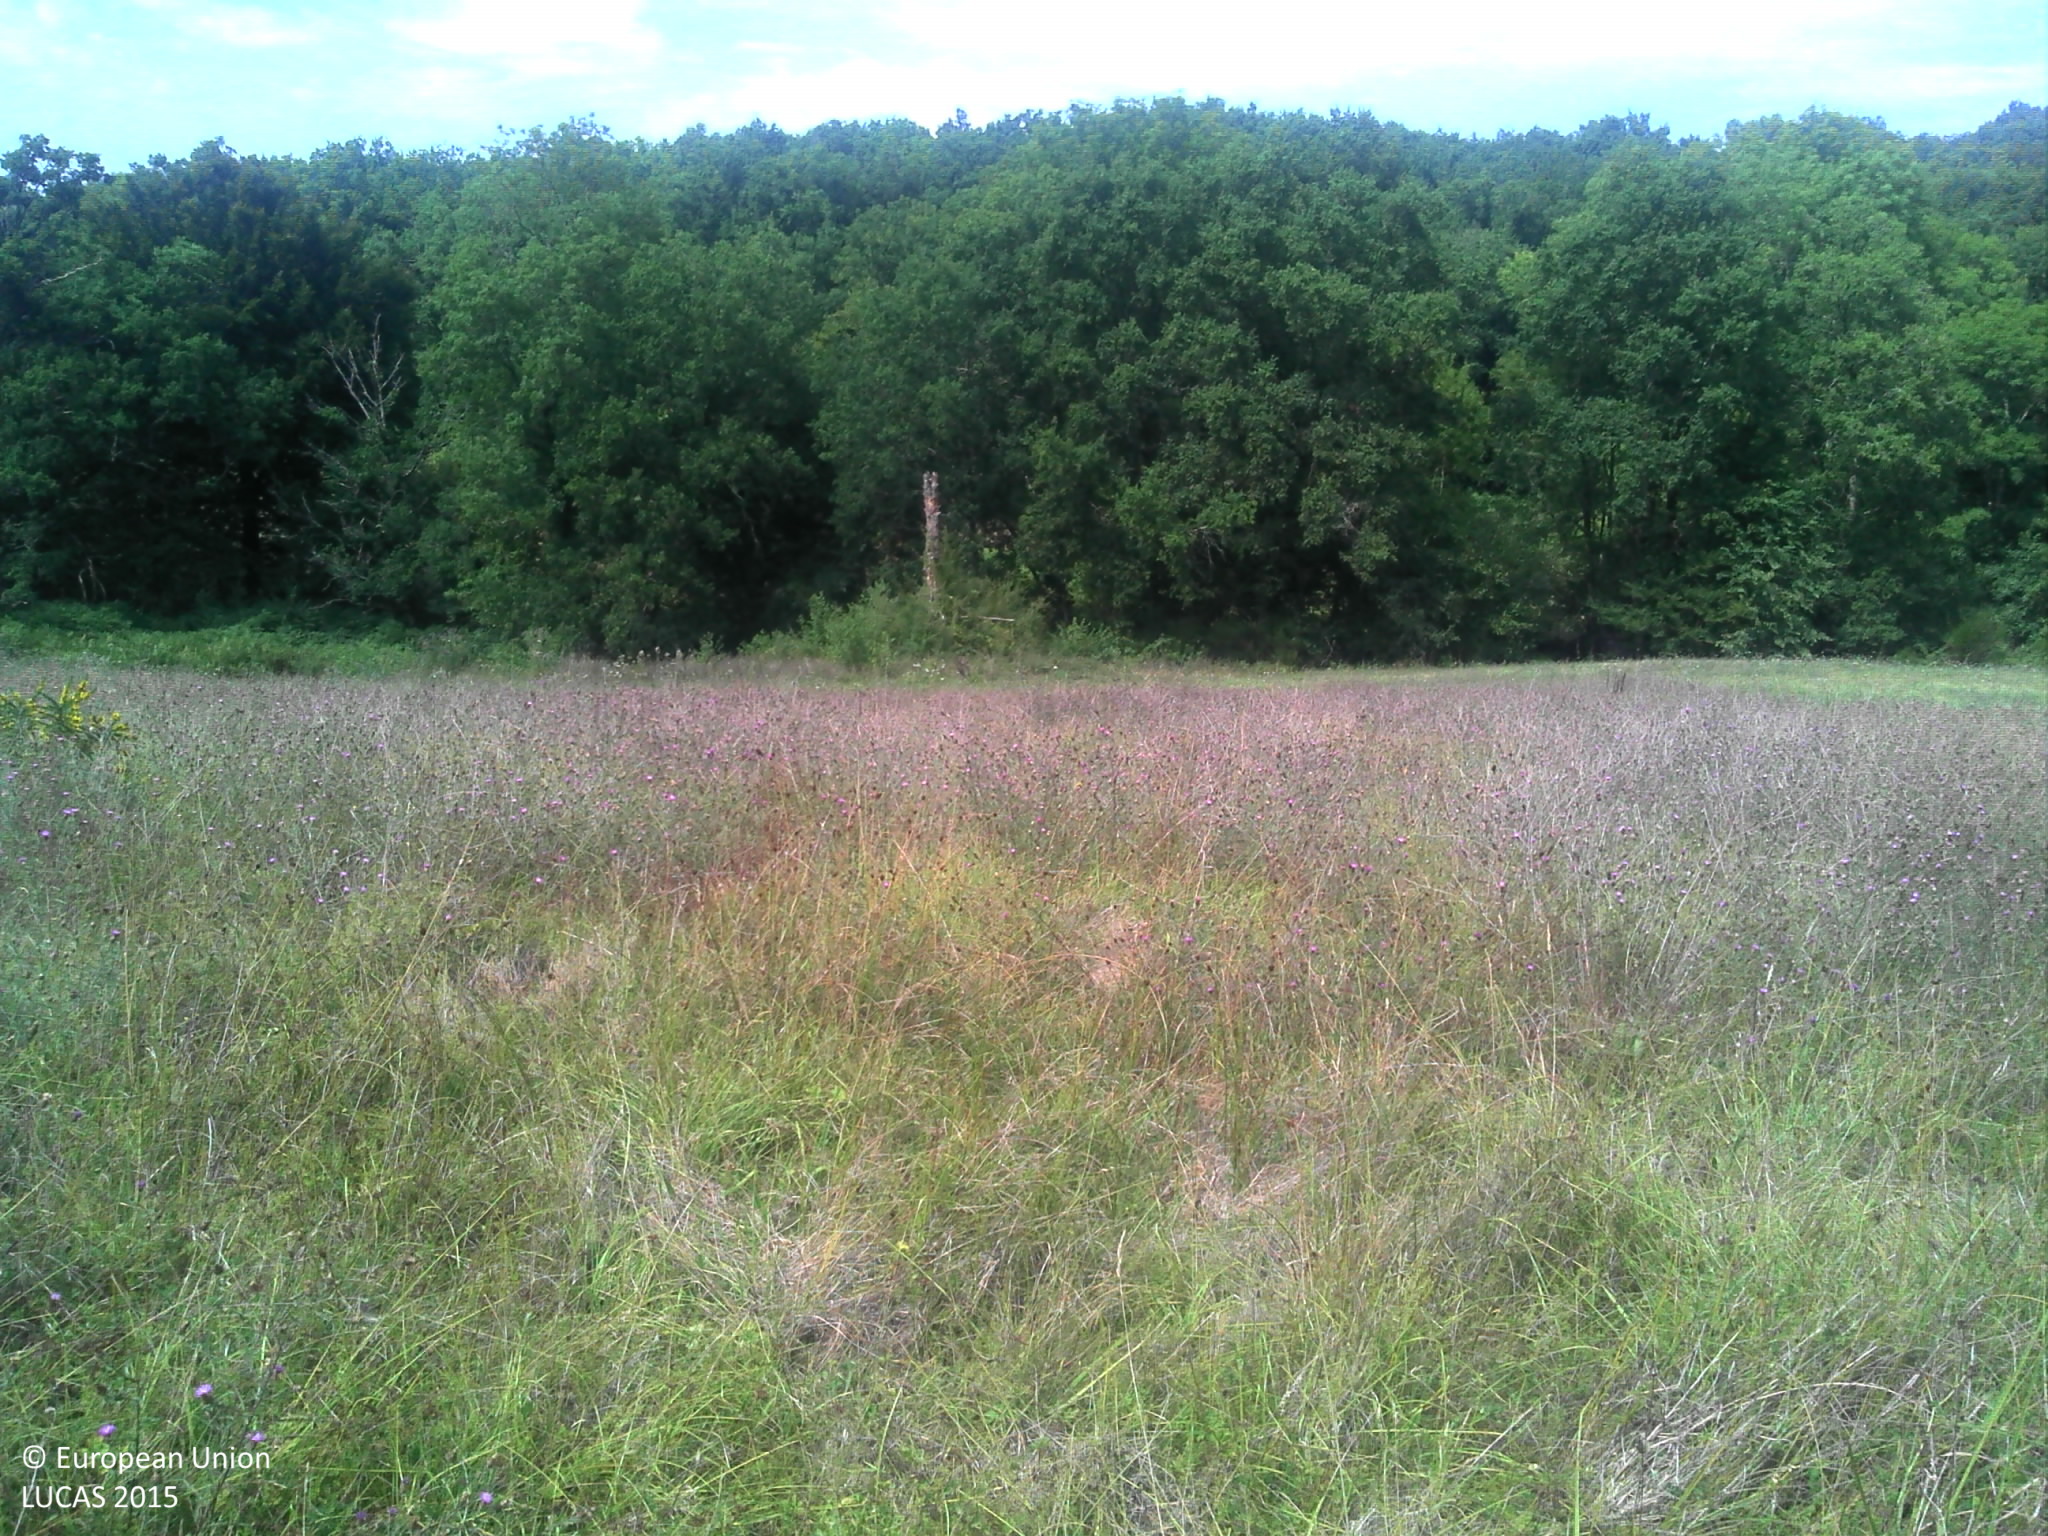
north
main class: Grassland
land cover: Spontaneously vegetated surfaces
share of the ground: > 75 %
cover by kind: herbaceous plants 95 %, shrubs 5 %
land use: Agriculture (excluding fallow land and kitchen gardens)
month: August
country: FR
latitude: 46.0935
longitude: 0.9466
